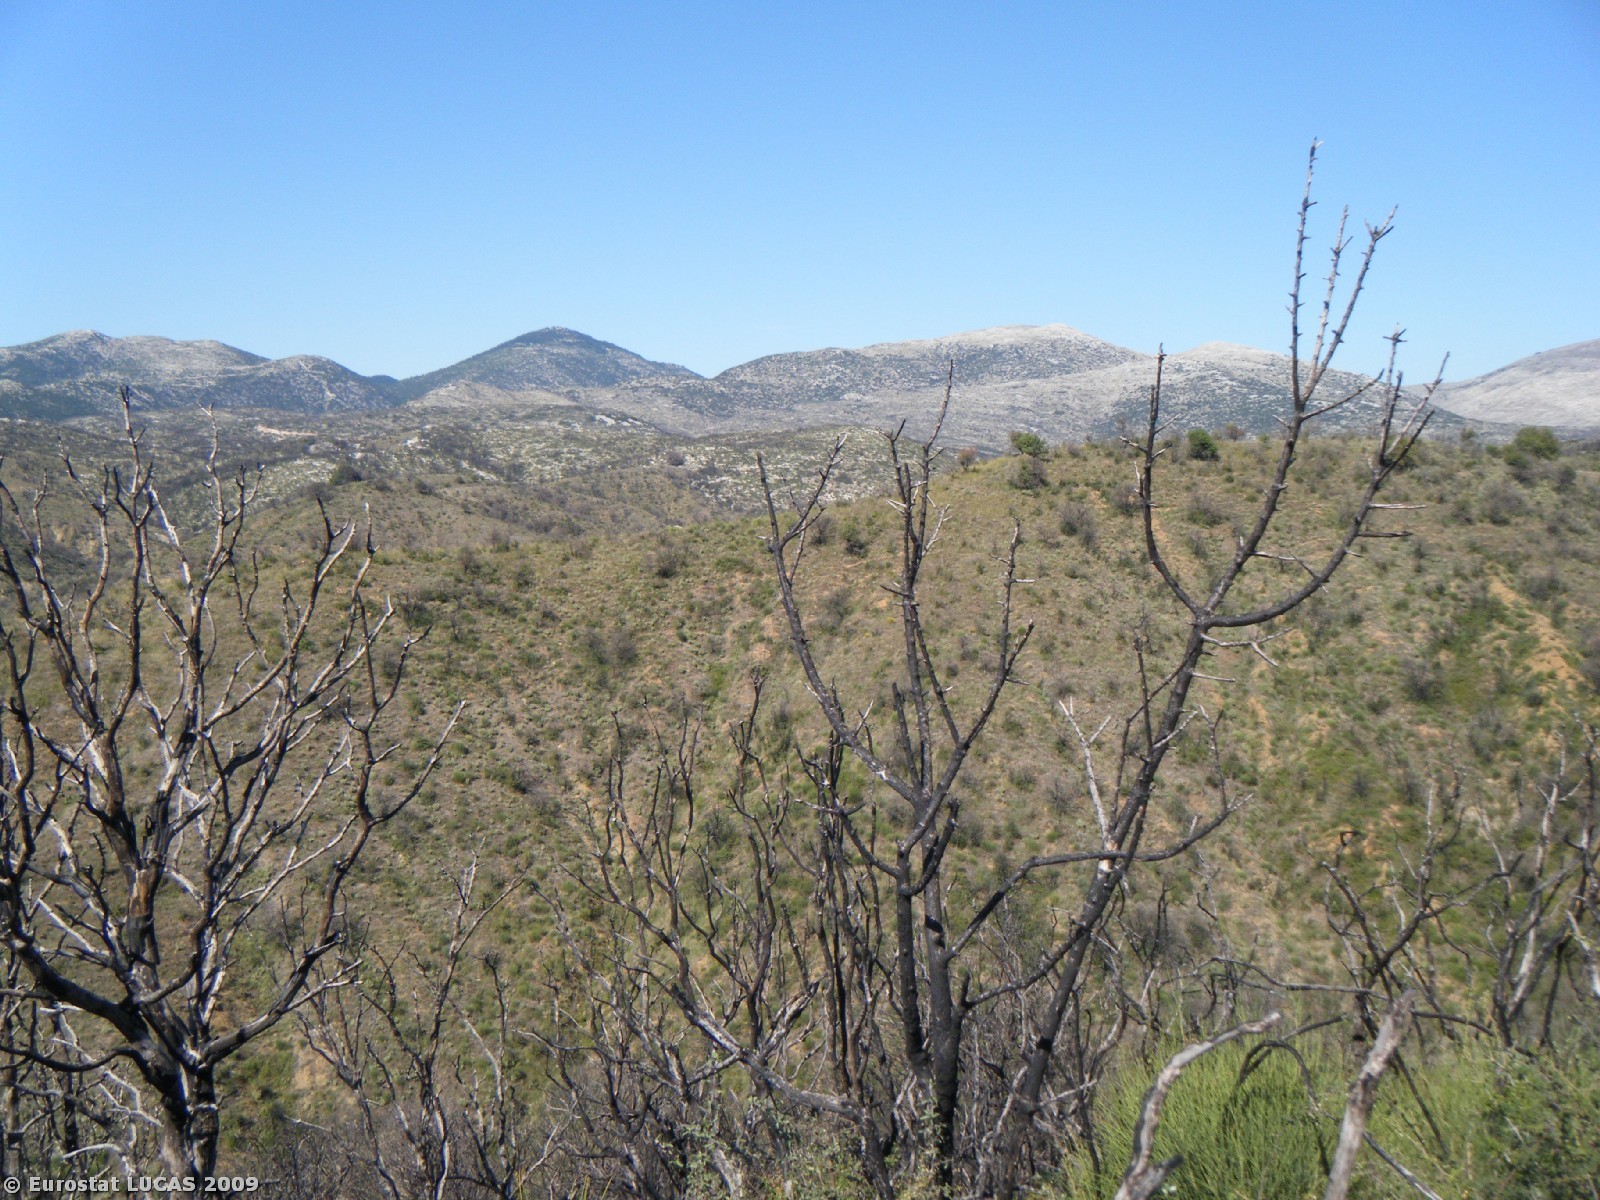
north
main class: Grassland
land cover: Grassland with sparse tree/shrub cover
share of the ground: > 75 %
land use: Unused
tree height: > 5 m
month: October
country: GR
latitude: 37.4324
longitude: 22.2217
